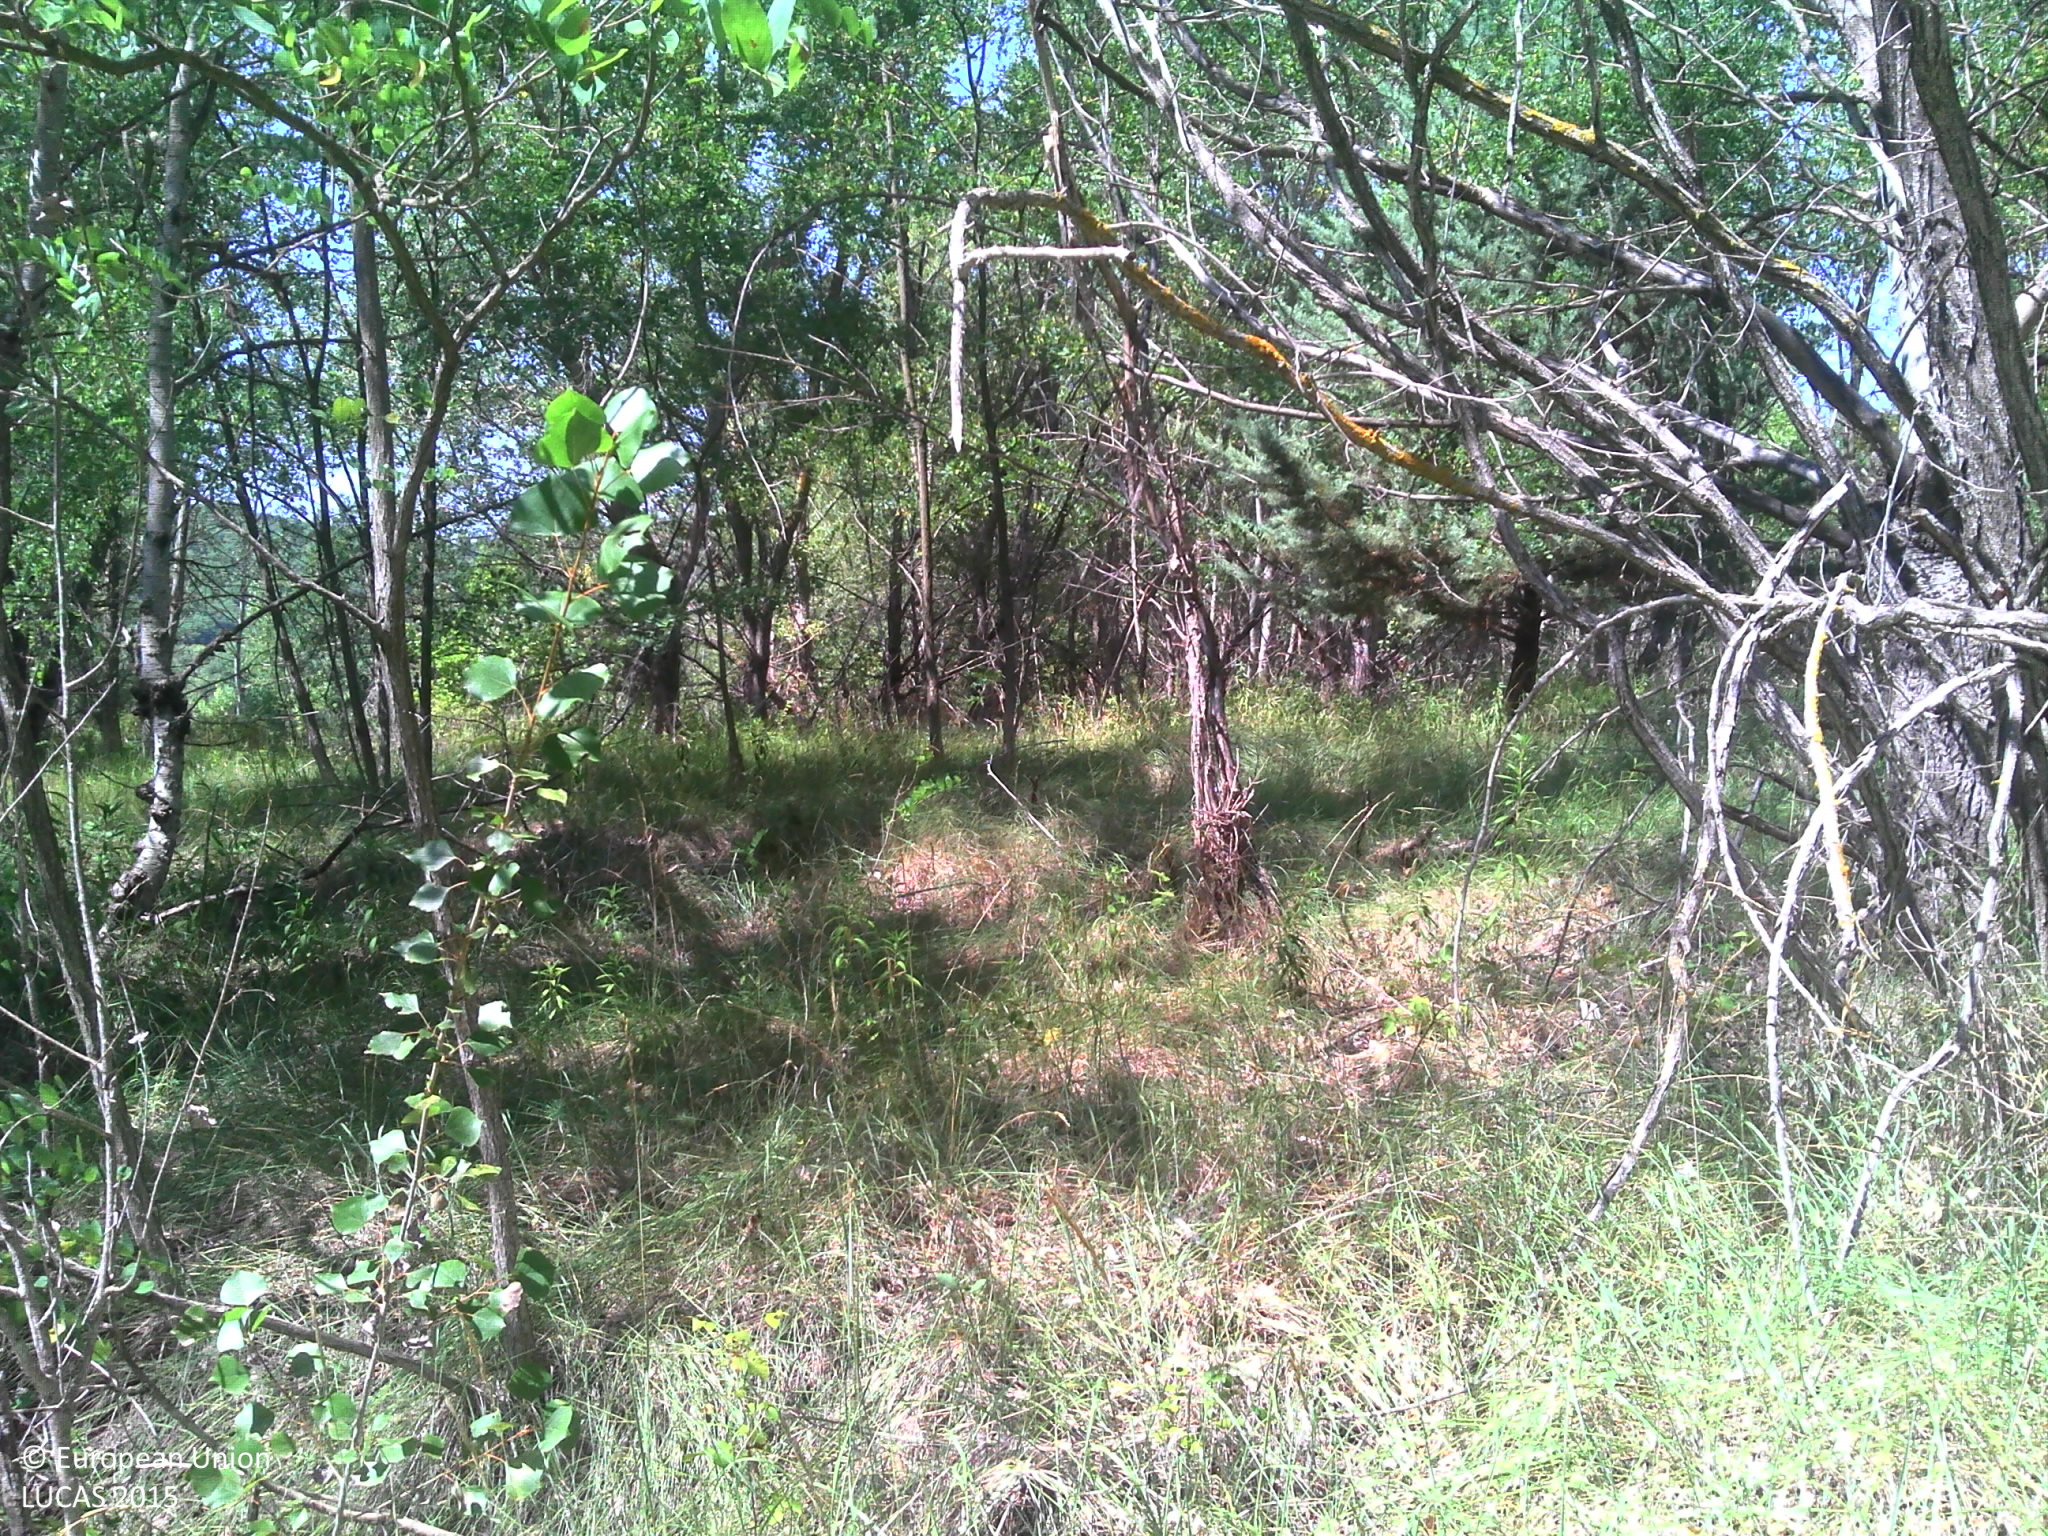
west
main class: Woodland
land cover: Broadleaved woodland
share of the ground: > 75 %
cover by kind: herbaceous plants 55 %, broadleaved forest trees 40 %, consolidated bare surface 5 %
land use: Semi-natural and natural areas not in use
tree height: > 5 m
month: August
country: FR
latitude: 43.7026
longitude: 5.7278
